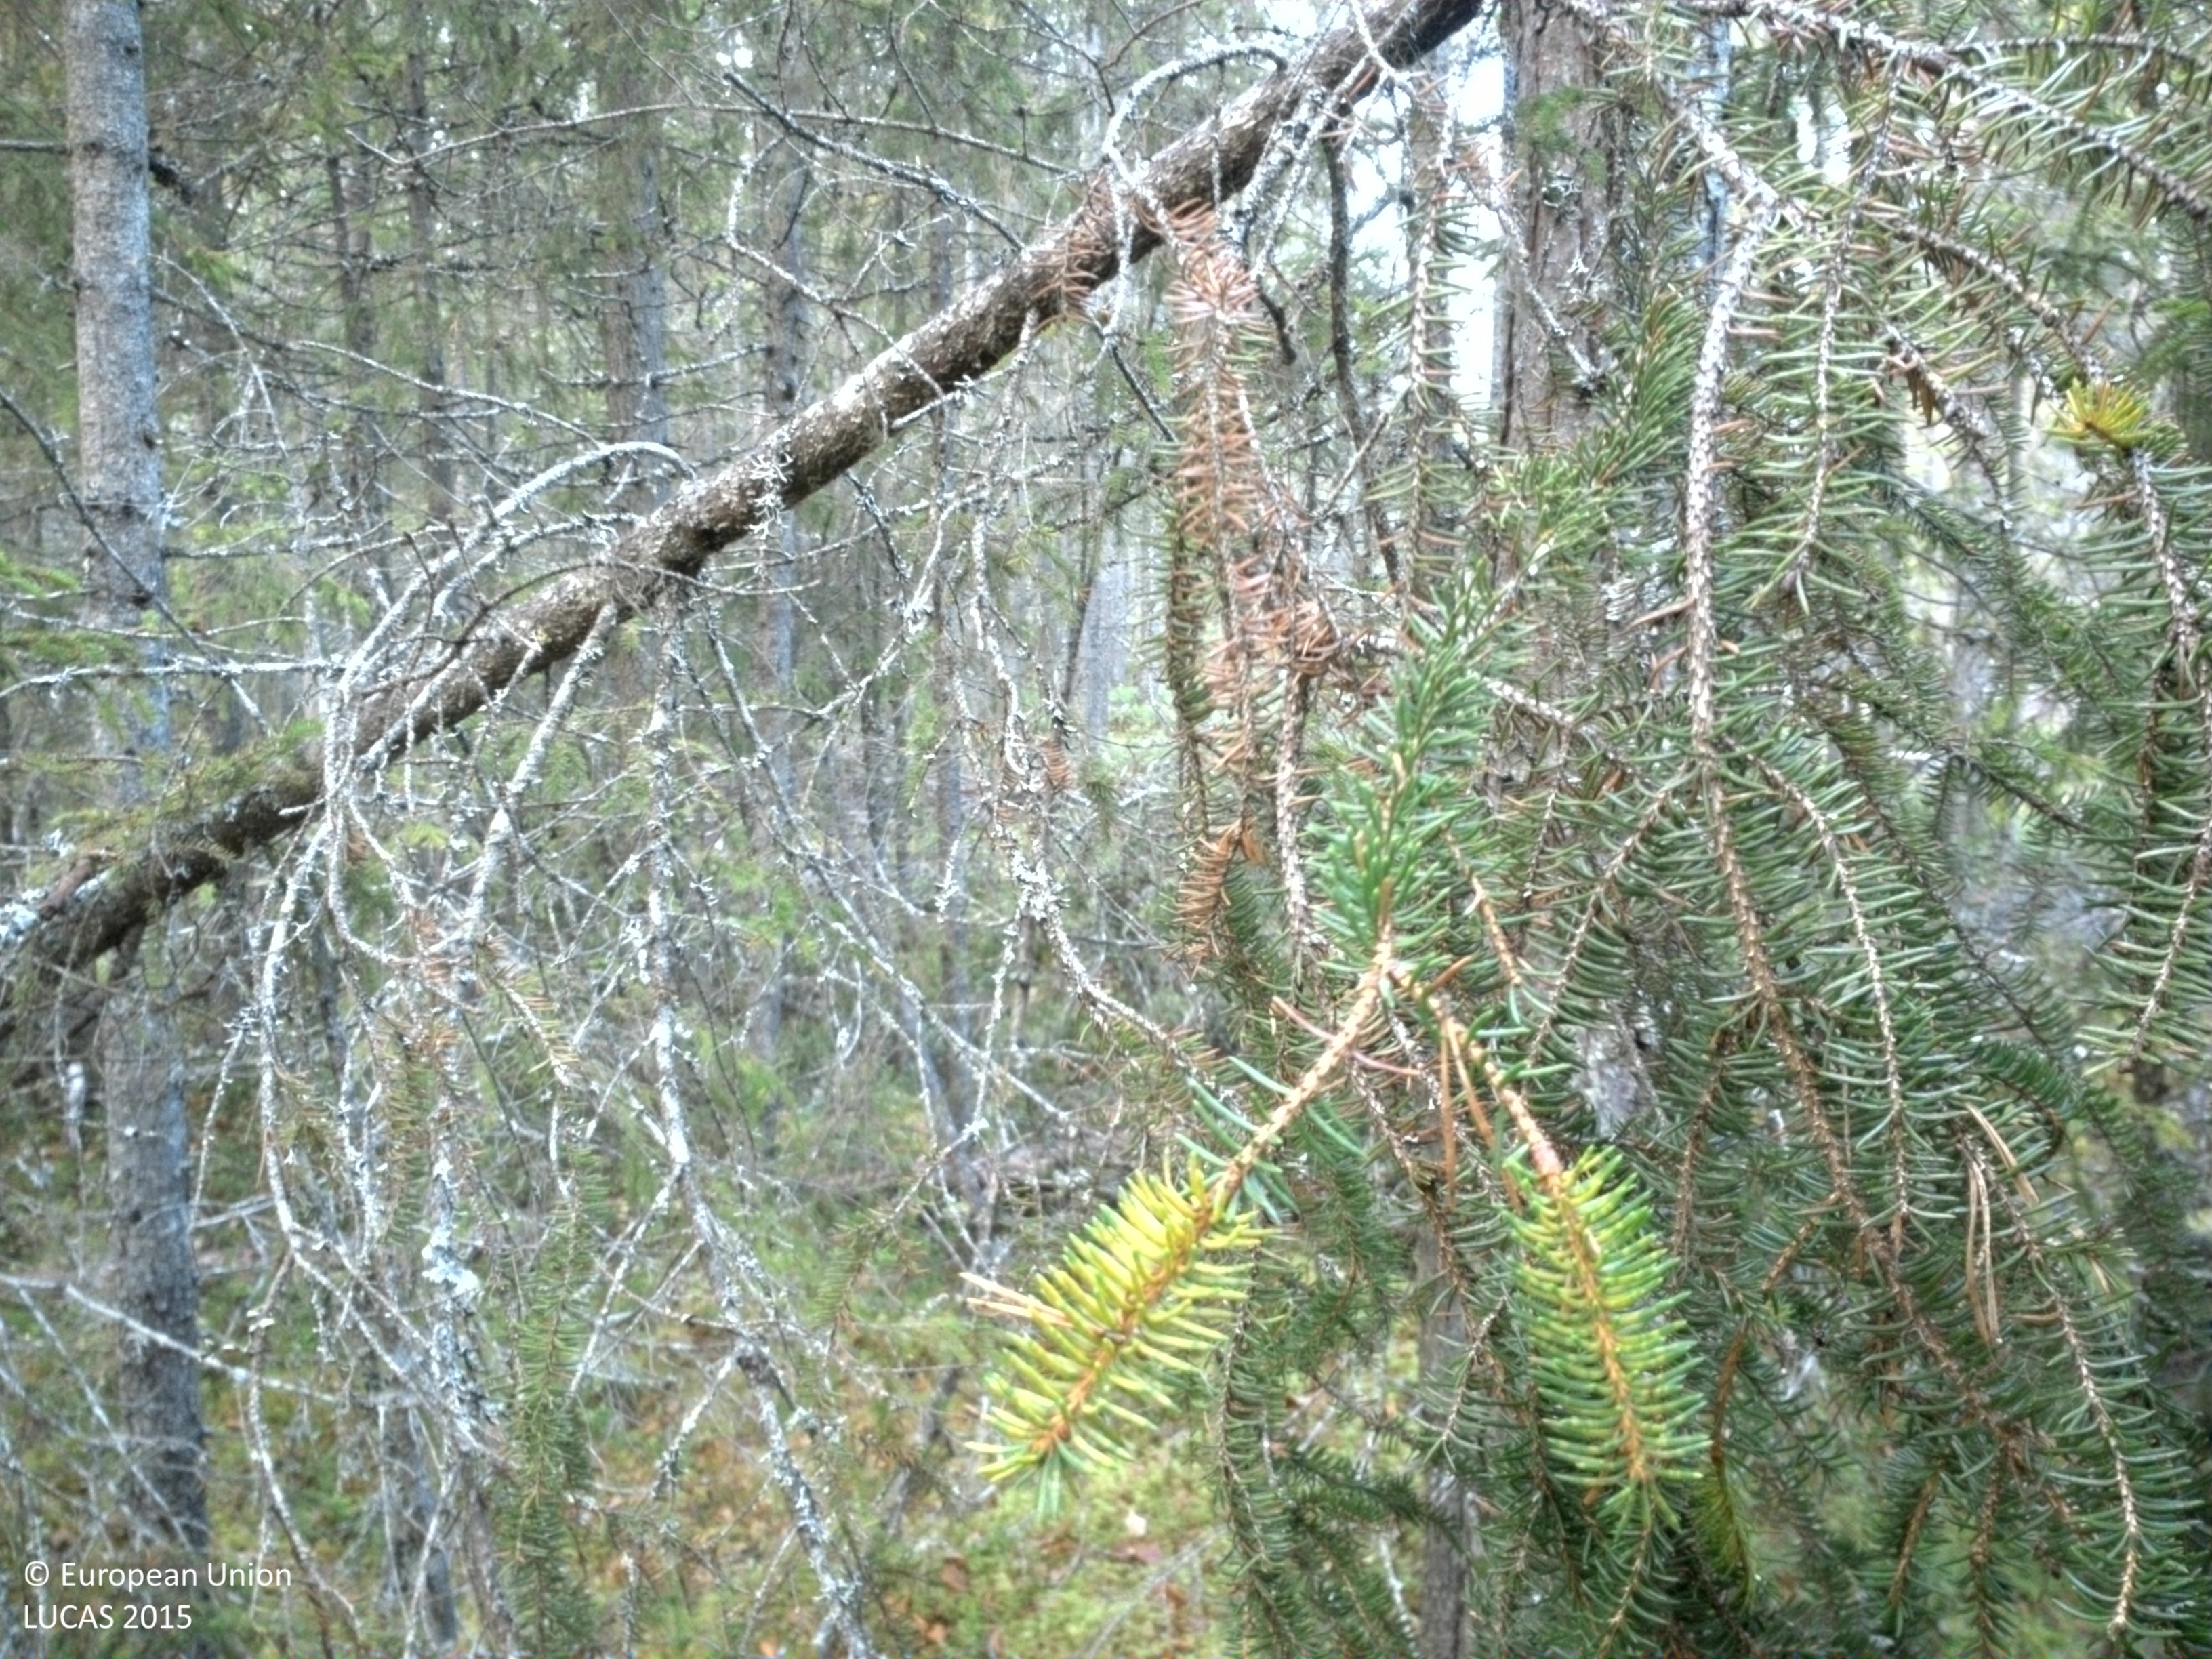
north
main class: Woodland
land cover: Spruce dominated coniferous woodland
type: boreal forest
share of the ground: 50 - 75 %
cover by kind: coniferous forest trees 65 %, shrubs 15 %, herbaceous plants 15 %, broadleaved forest trees 5 %
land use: Forestry
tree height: > 5 m
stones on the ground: < 10 %
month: October
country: SE
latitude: 64.5483
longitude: 16.6619
